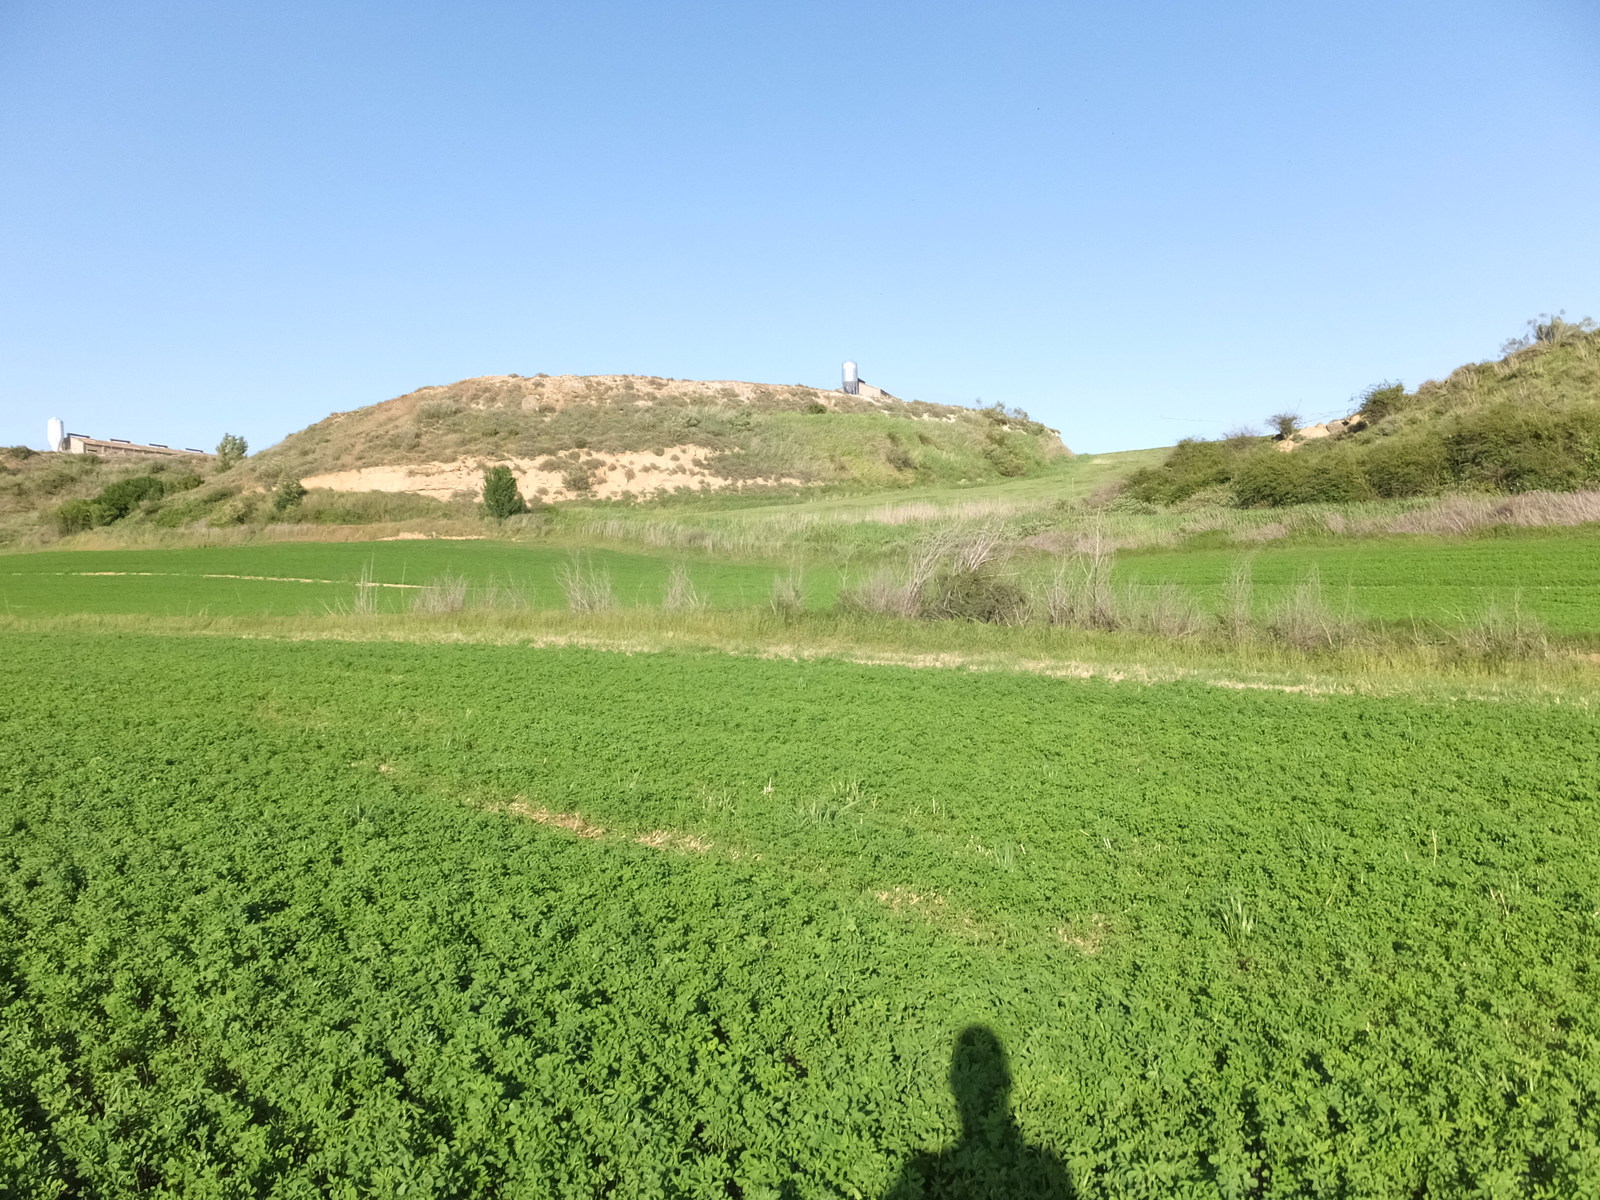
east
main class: Cropland
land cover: Lucerne
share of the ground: > 75 %
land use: Agriculture (excluding fallow land and kitchen gardens)
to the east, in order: Lucerne; Grass margins; Ditches and canals; Grass margins; Lucerne; Shrubland without tree cover; Common wheat; Shrubland without tree cover; Tracks; Artificial constructions in urban areas
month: May
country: ES
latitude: 41.6353
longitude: 0.4190
